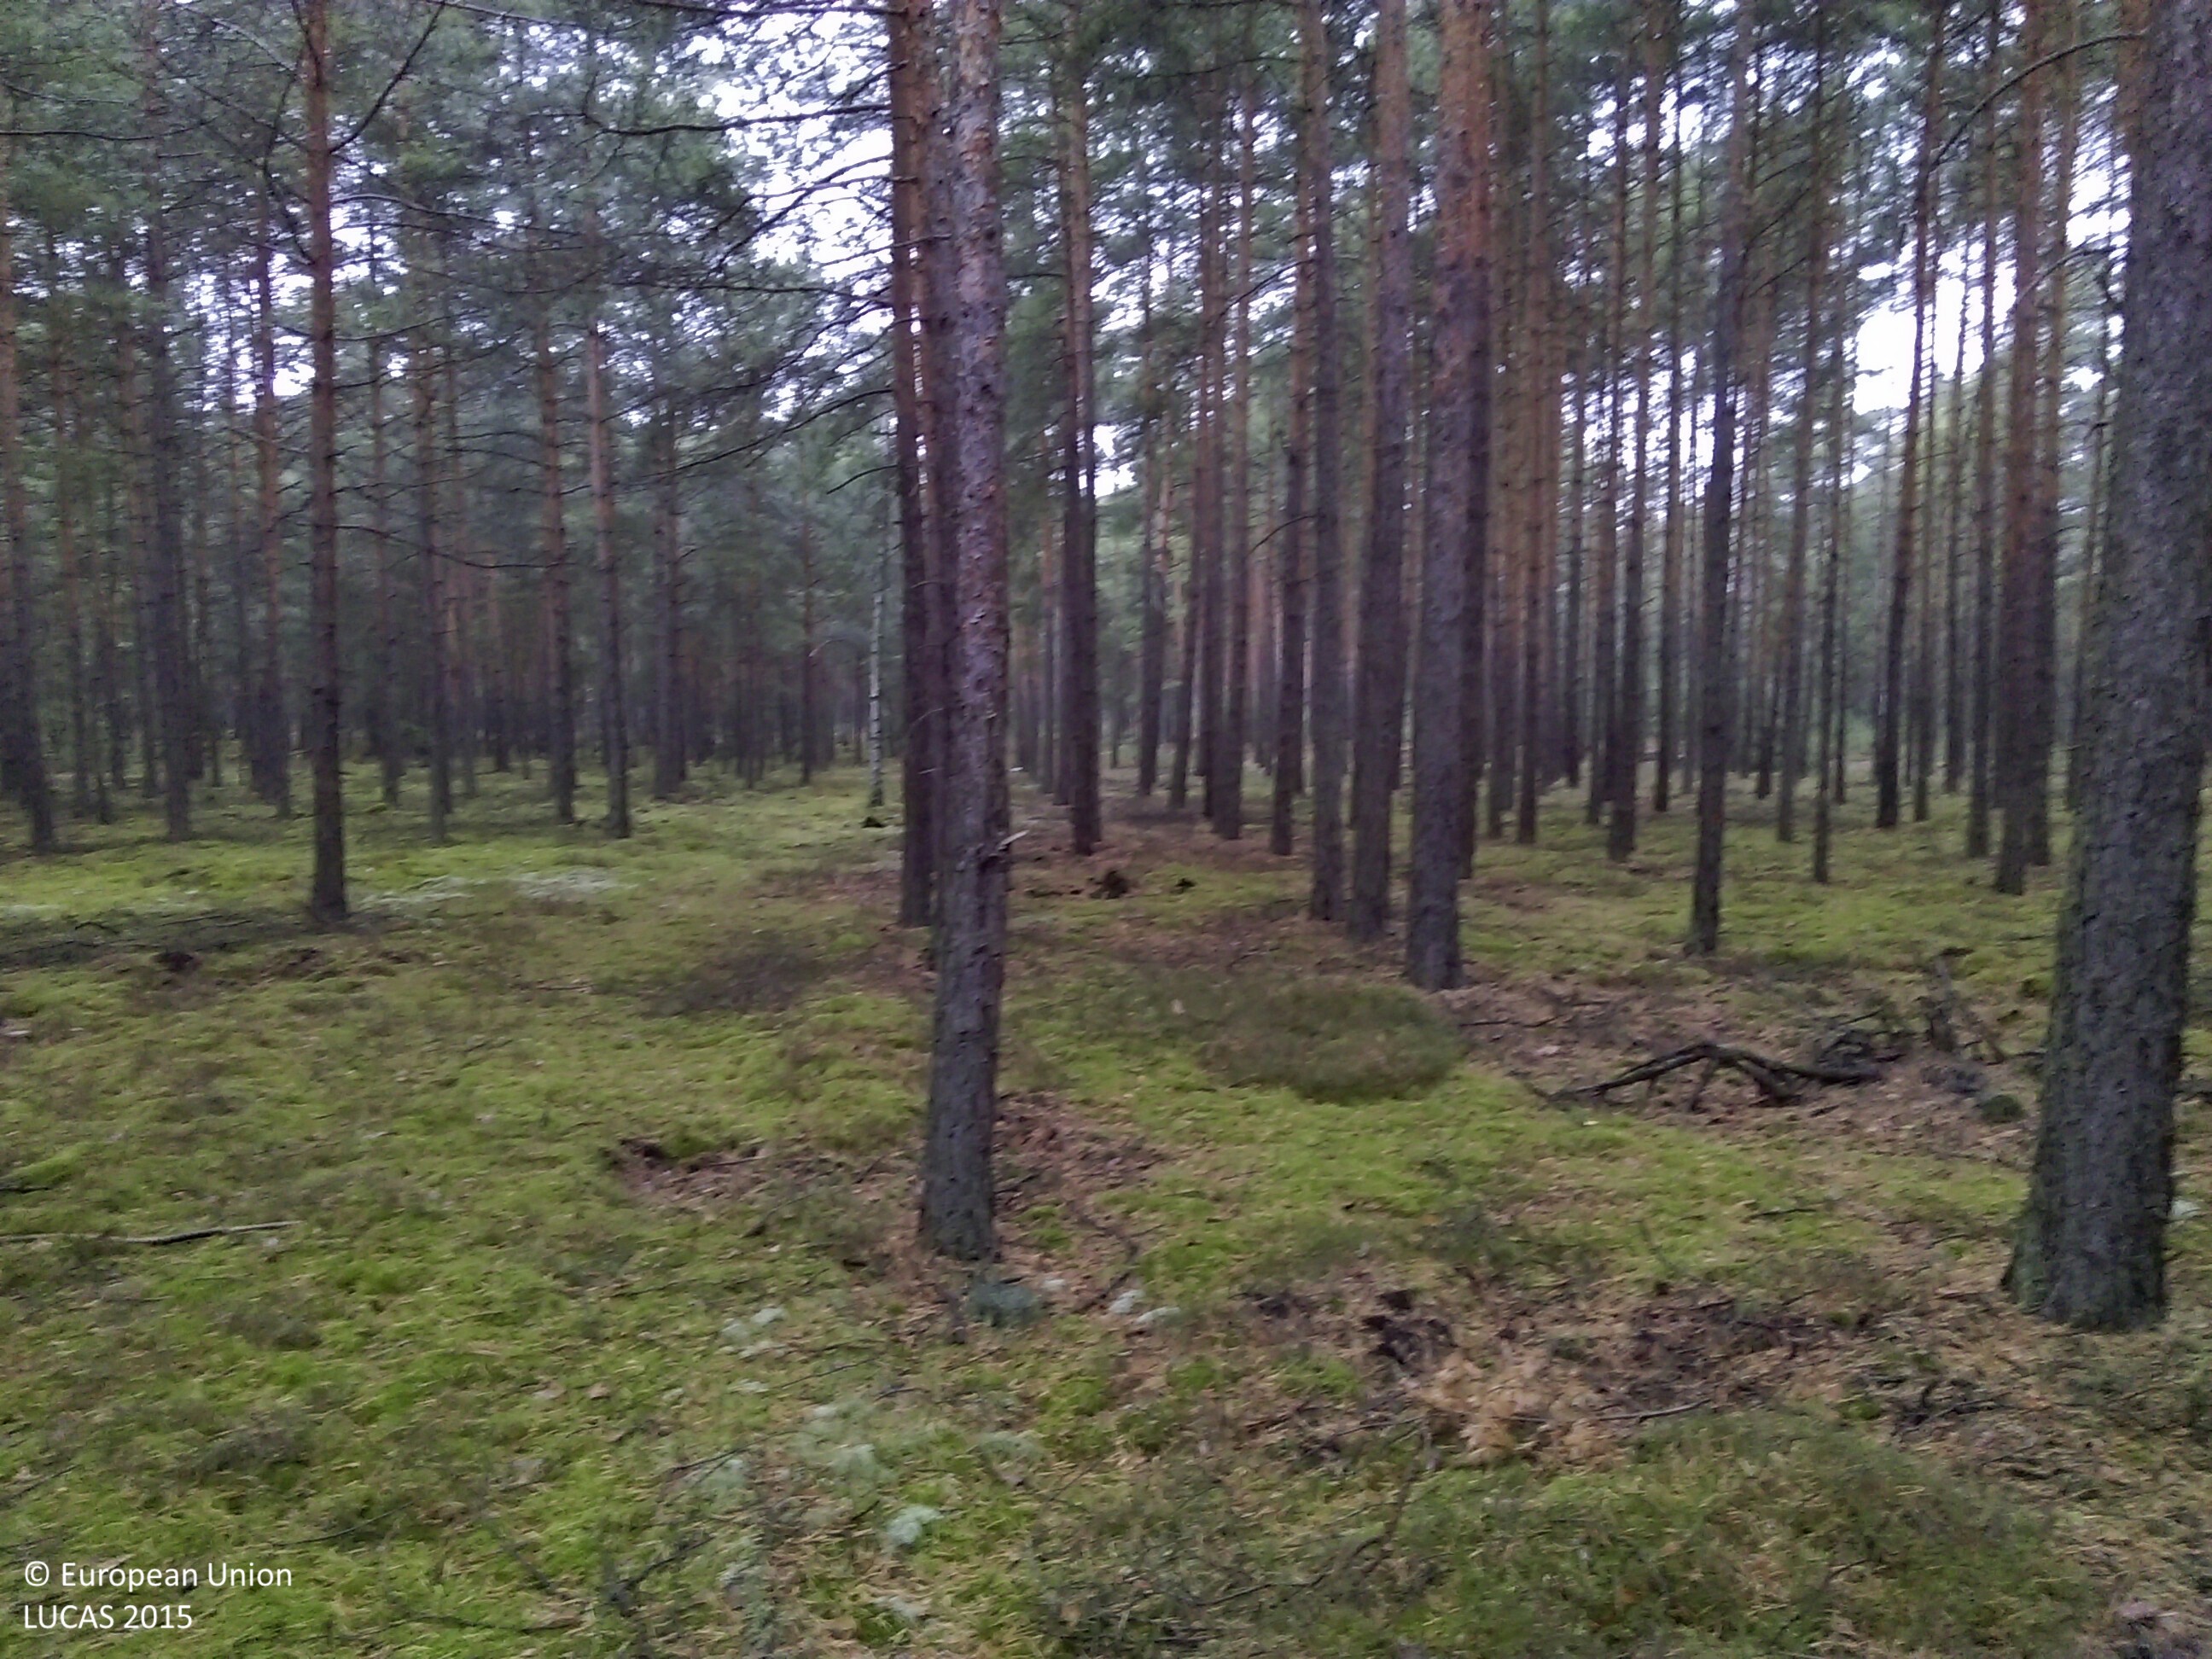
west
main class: Woodland
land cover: Pine dominated coniferous woodland
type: hemiboreal forest and nemoral coniferous forest and mixed broadleaved-coniferous forest
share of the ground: > 75 %
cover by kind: coniferous forest trees 85 %, lichens and mosses 15 %
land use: Forestry
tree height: > 5 m
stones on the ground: < 10 %
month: November
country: PL
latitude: 51.9581
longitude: 15.5778
